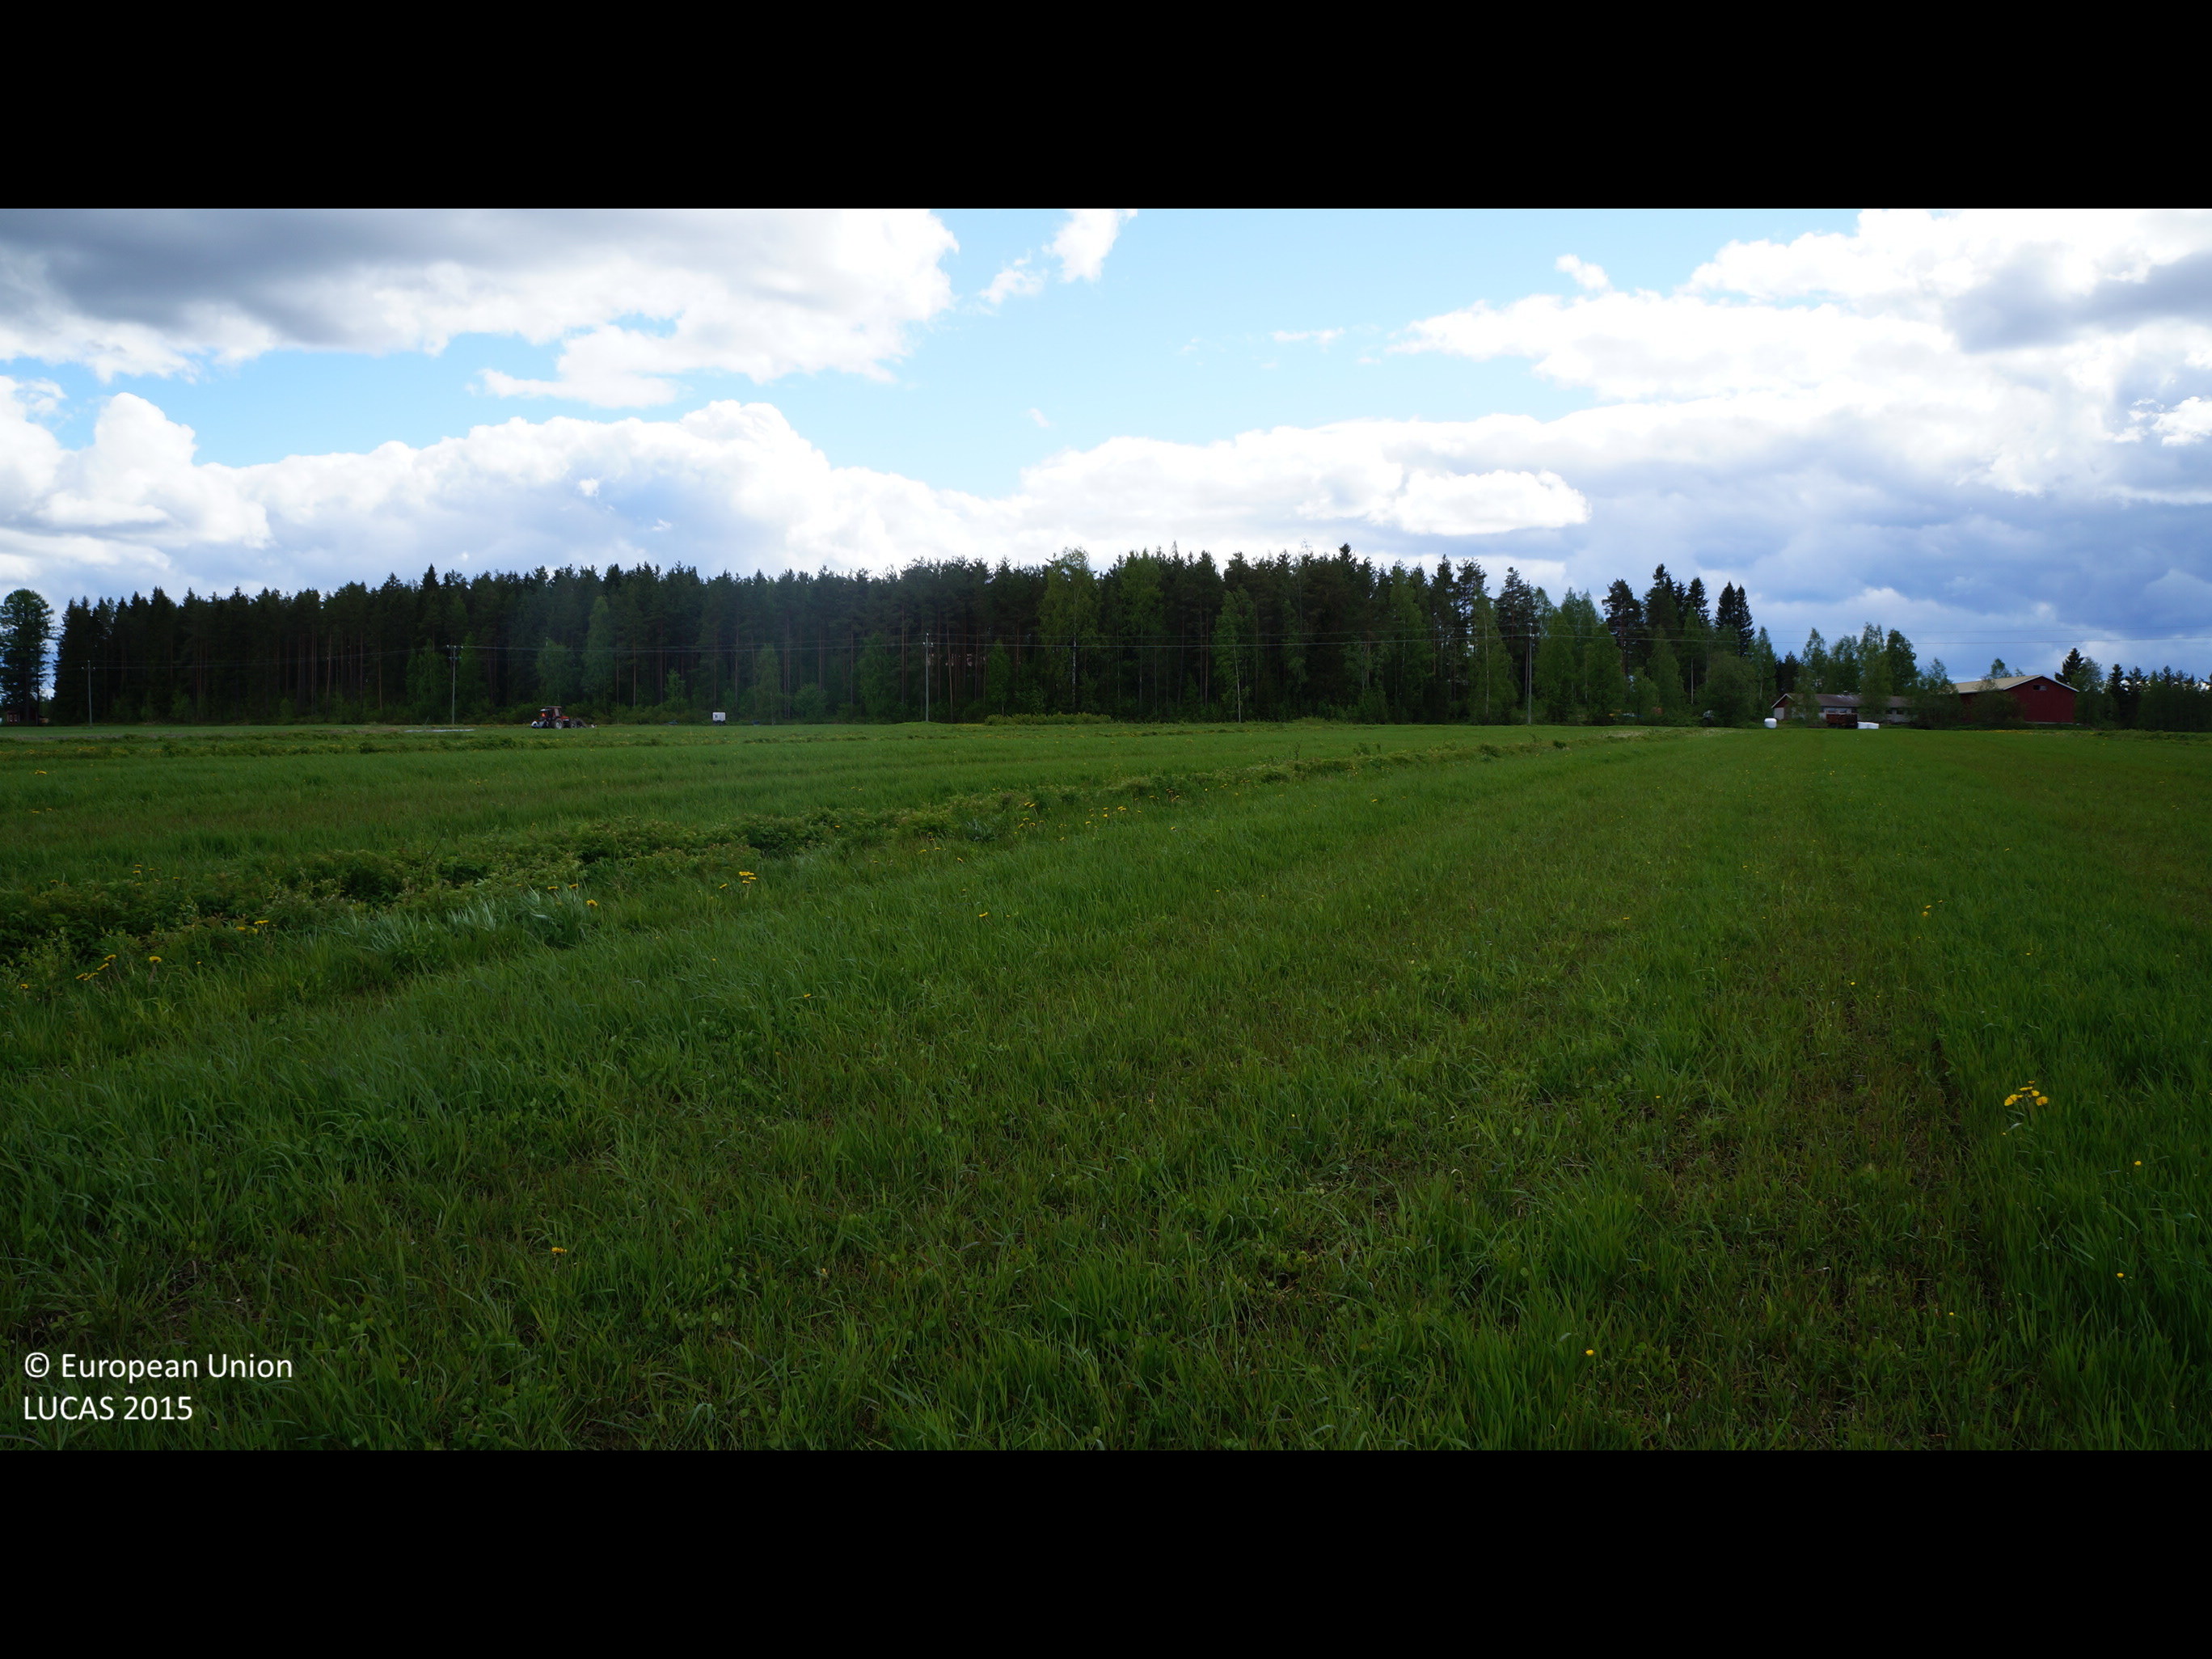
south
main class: Cropland
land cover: Temporary grasslands
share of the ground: > 75 %
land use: Agriculture (excluding fallow land and kitchen gardens)
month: June
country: FI
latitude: 63.7942
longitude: 24.1770
